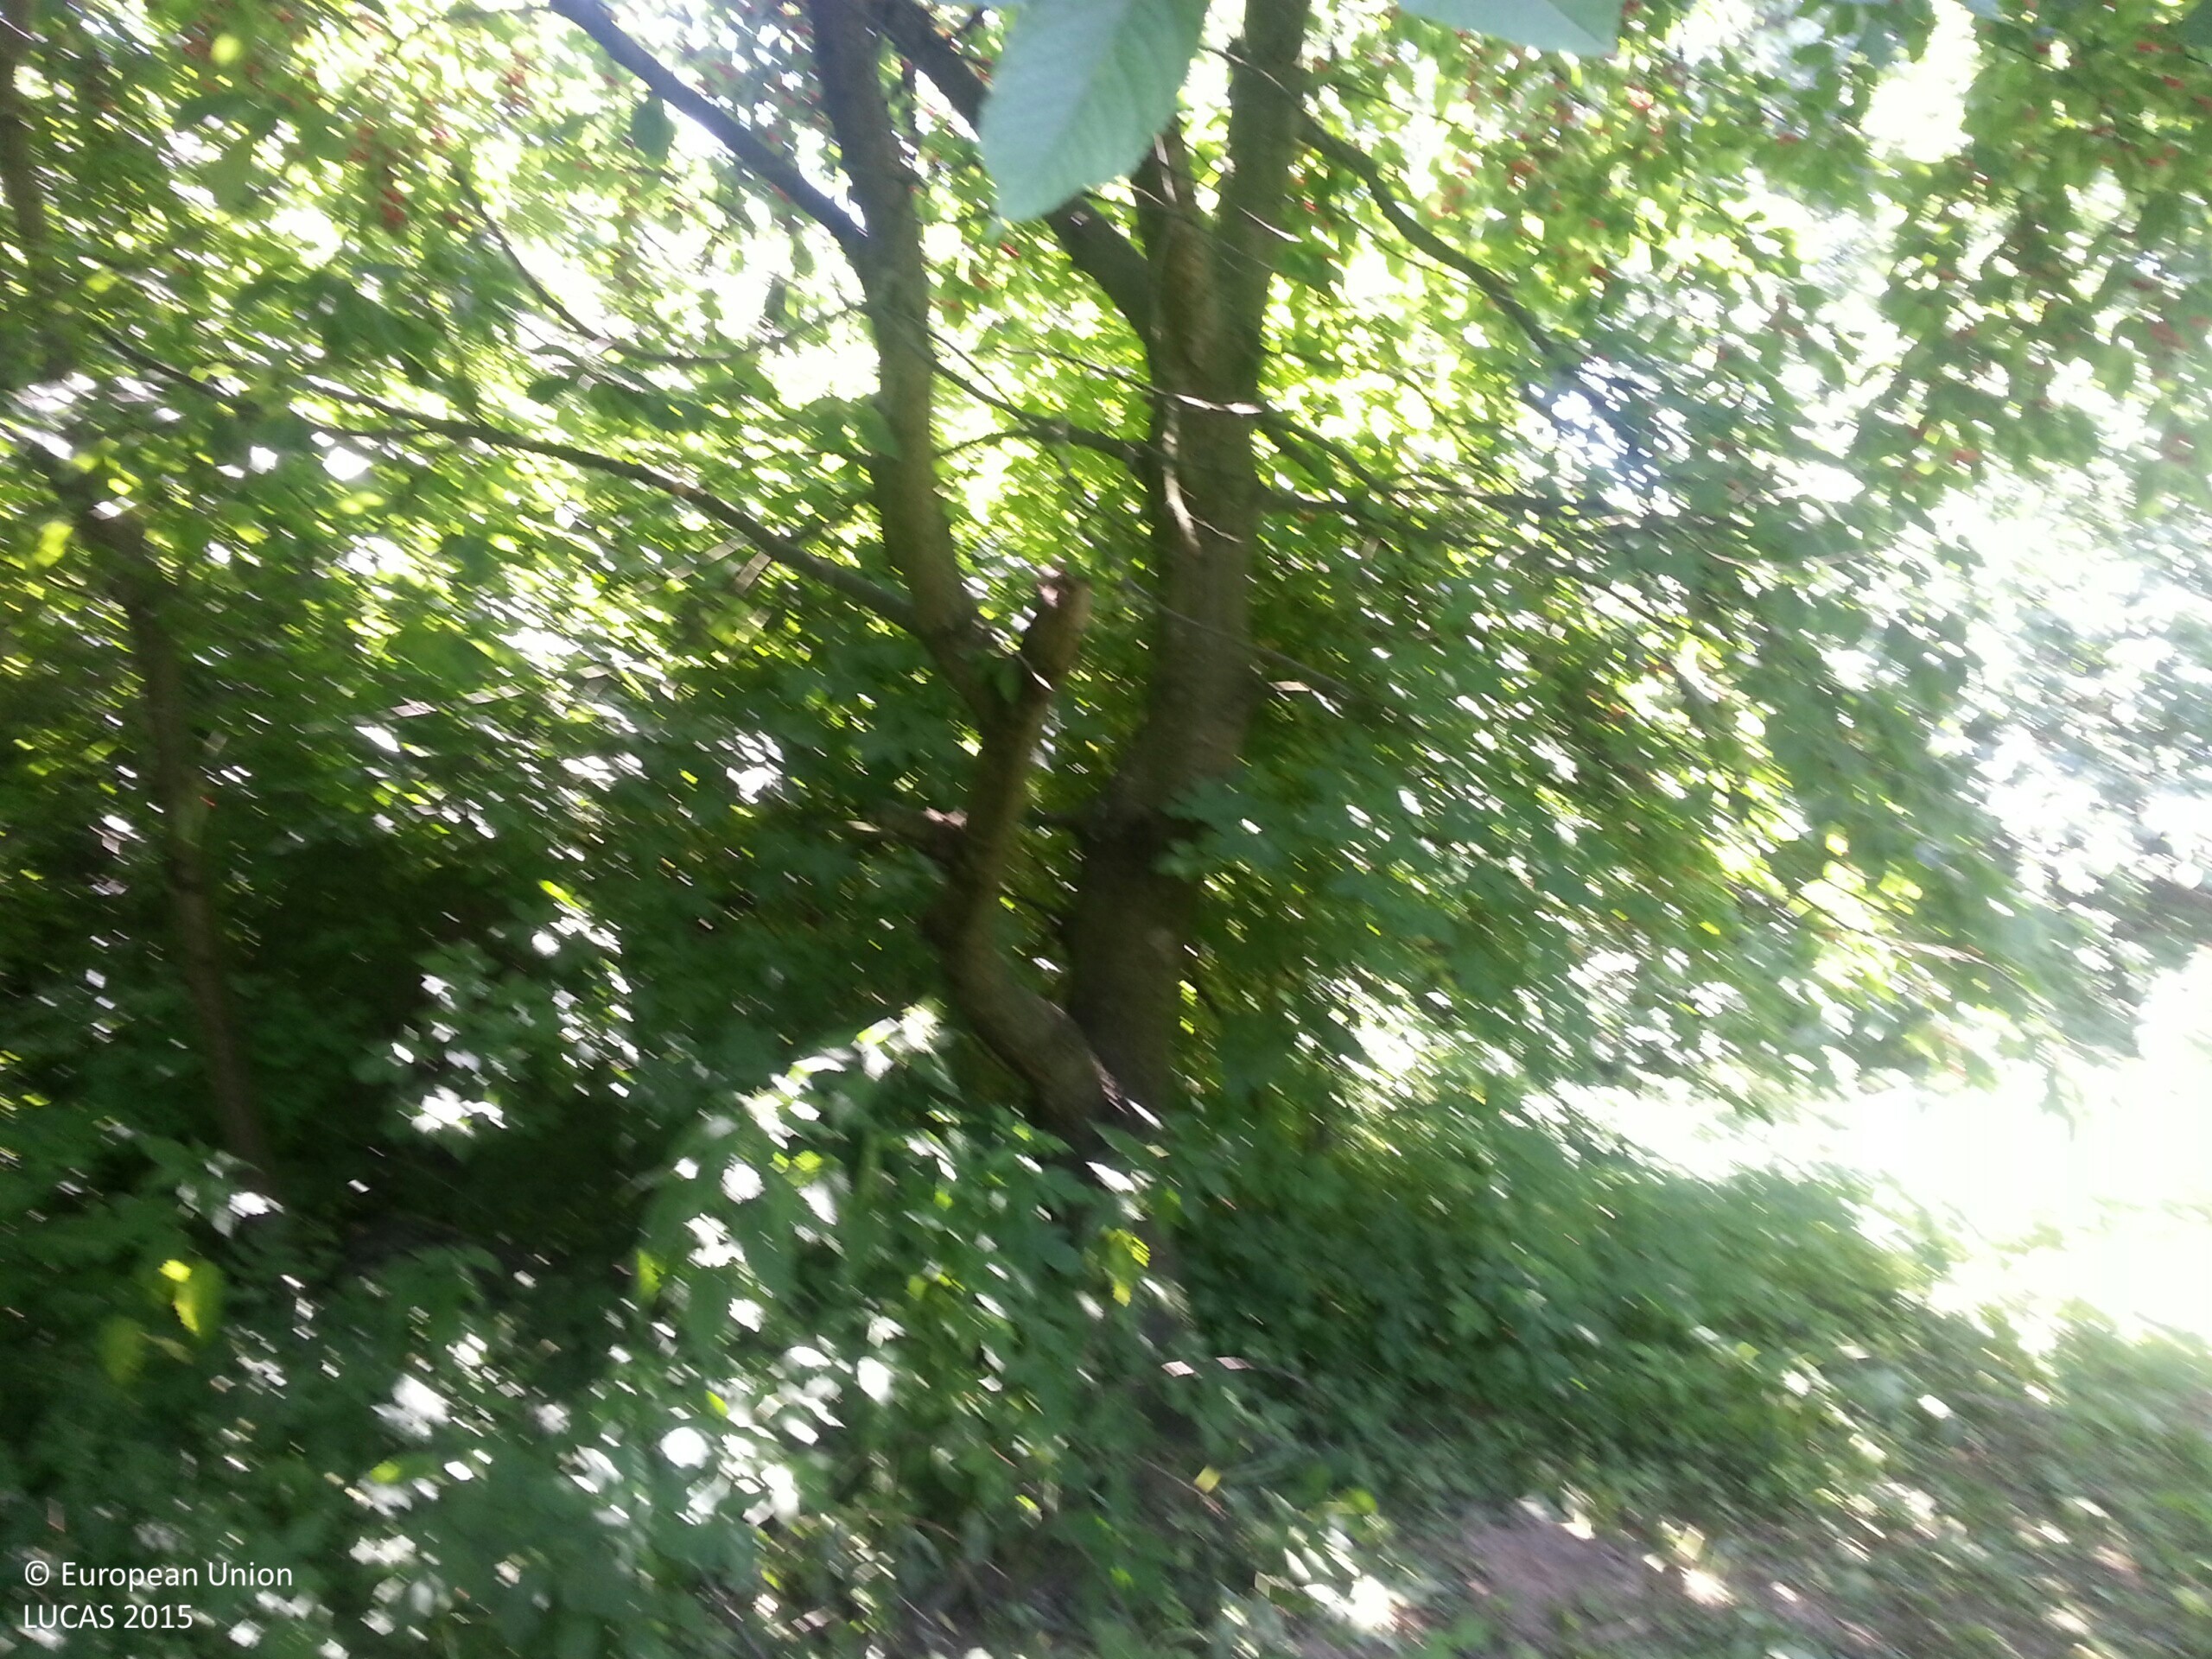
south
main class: Shrubland
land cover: Shrubland with sparse tree cover
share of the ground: 50 - 75 %
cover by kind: shrubs 70 %, herbaceous plants 25 %, broadleaved forest trees 5 %
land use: Agriculture (excluding fallow land and kitchen gardens)
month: July
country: PL
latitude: 50.2791
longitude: 20.2935
